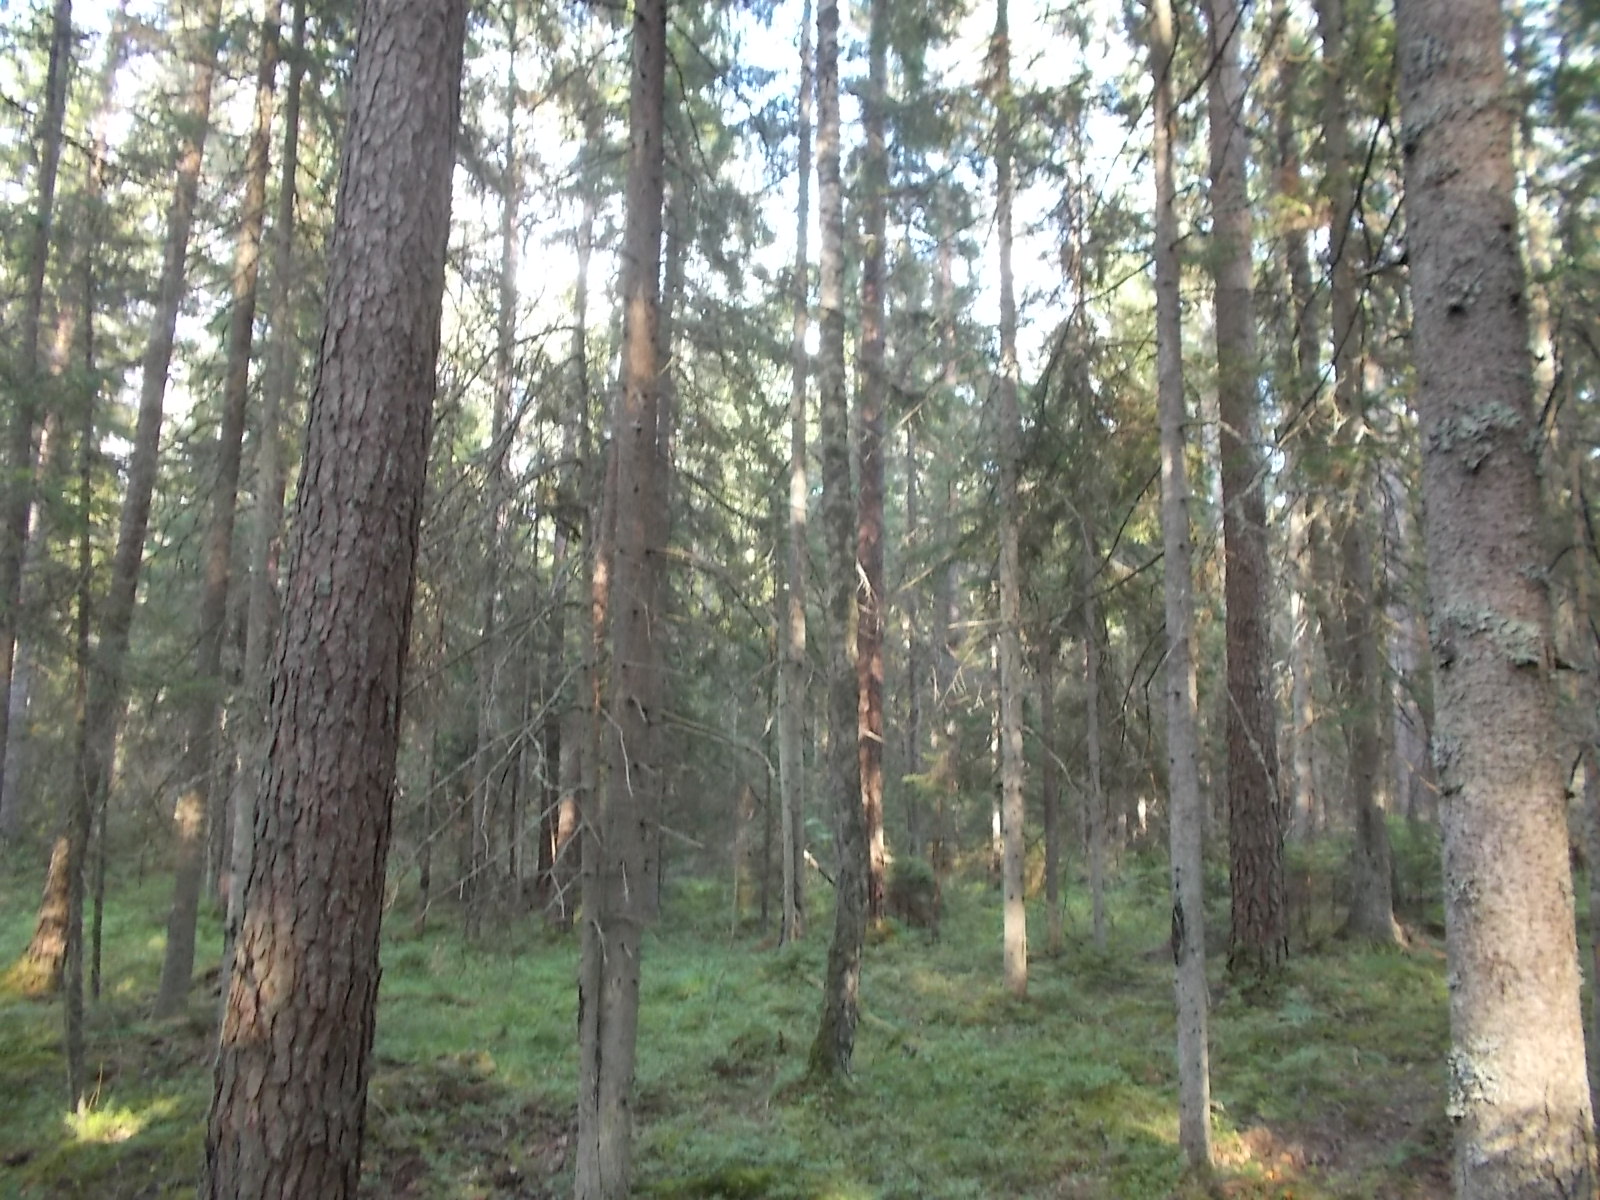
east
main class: Woodland
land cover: Other coniferous woodland
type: hemiboreal forest and nemoral coniferous forest and mixed broadleaved-coniferous forest
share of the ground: 50 - 75 %
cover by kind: coniferous forest trees 70 %, broadleaved forest trees 10 %, shrubs 10 %, herbaceous plants 10 %
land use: Forestry
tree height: > 5 m
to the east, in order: Other coniferous woodland
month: August
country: LV
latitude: 57.1016
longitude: 21.7472
